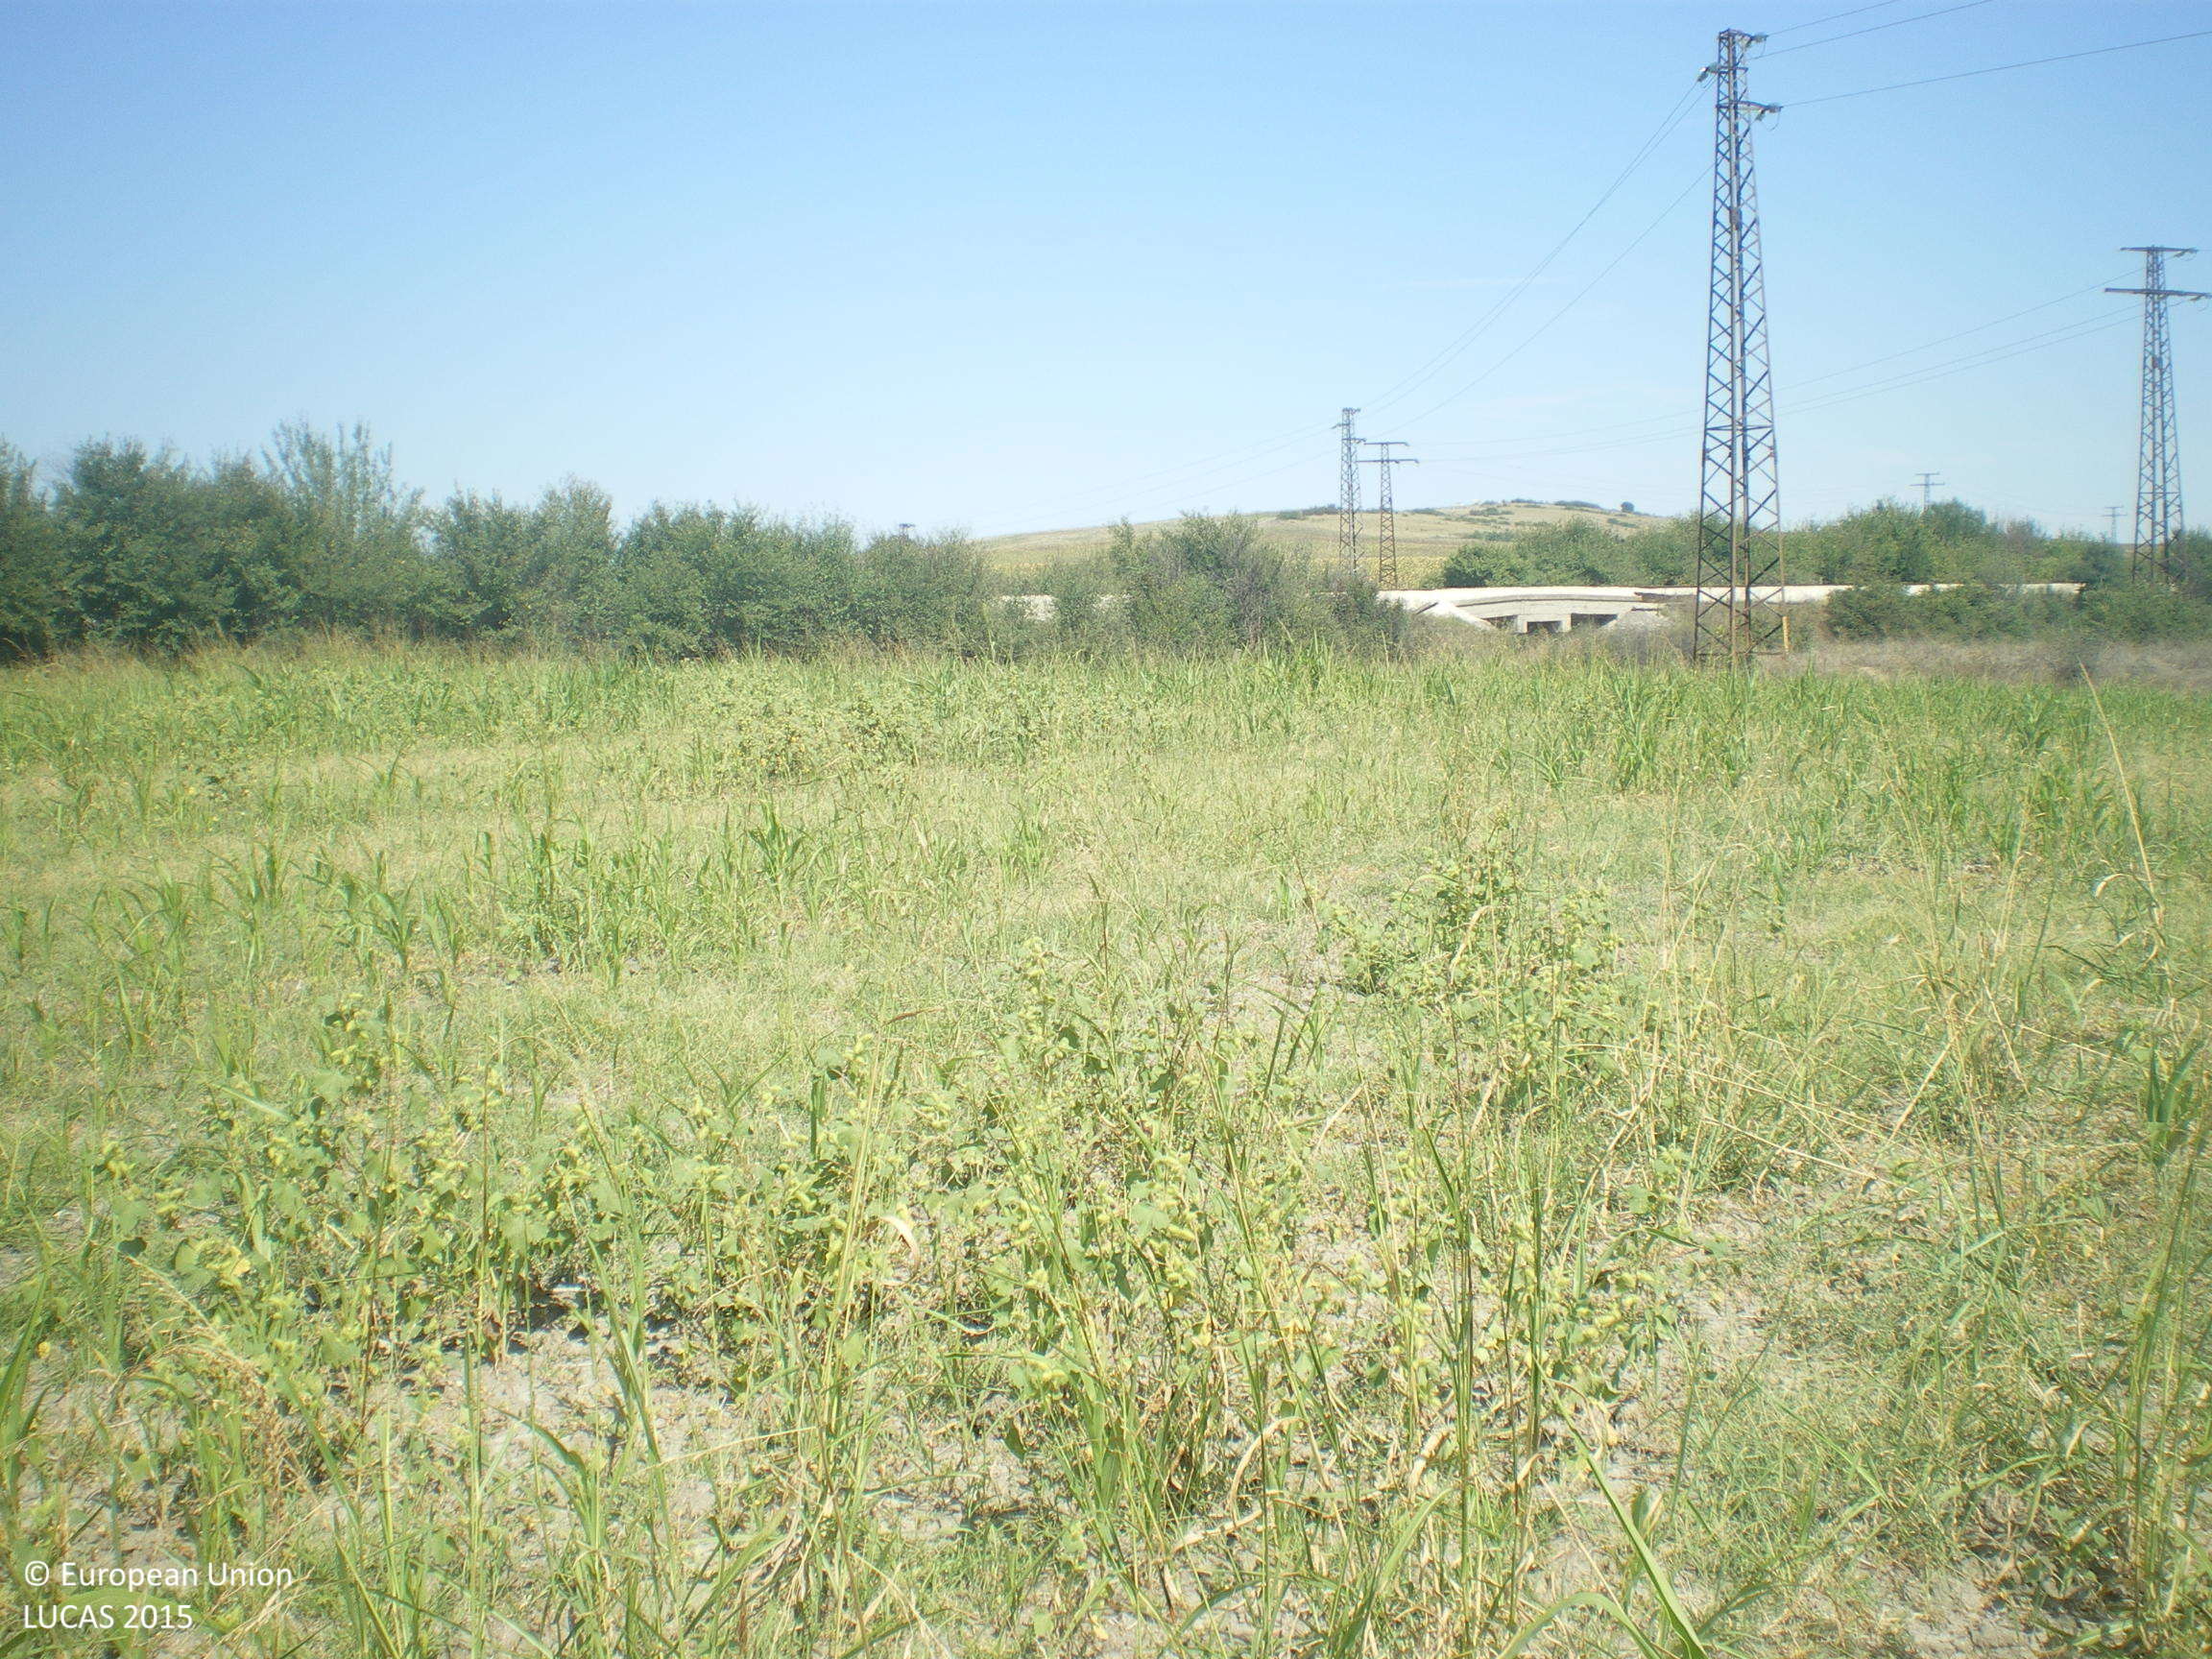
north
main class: Cropland
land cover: Maize
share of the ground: < 10 %
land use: Agriculture (excluding fallow land and kitchen gardens)
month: September
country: BG
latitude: 42.1651
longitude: 25.8697
